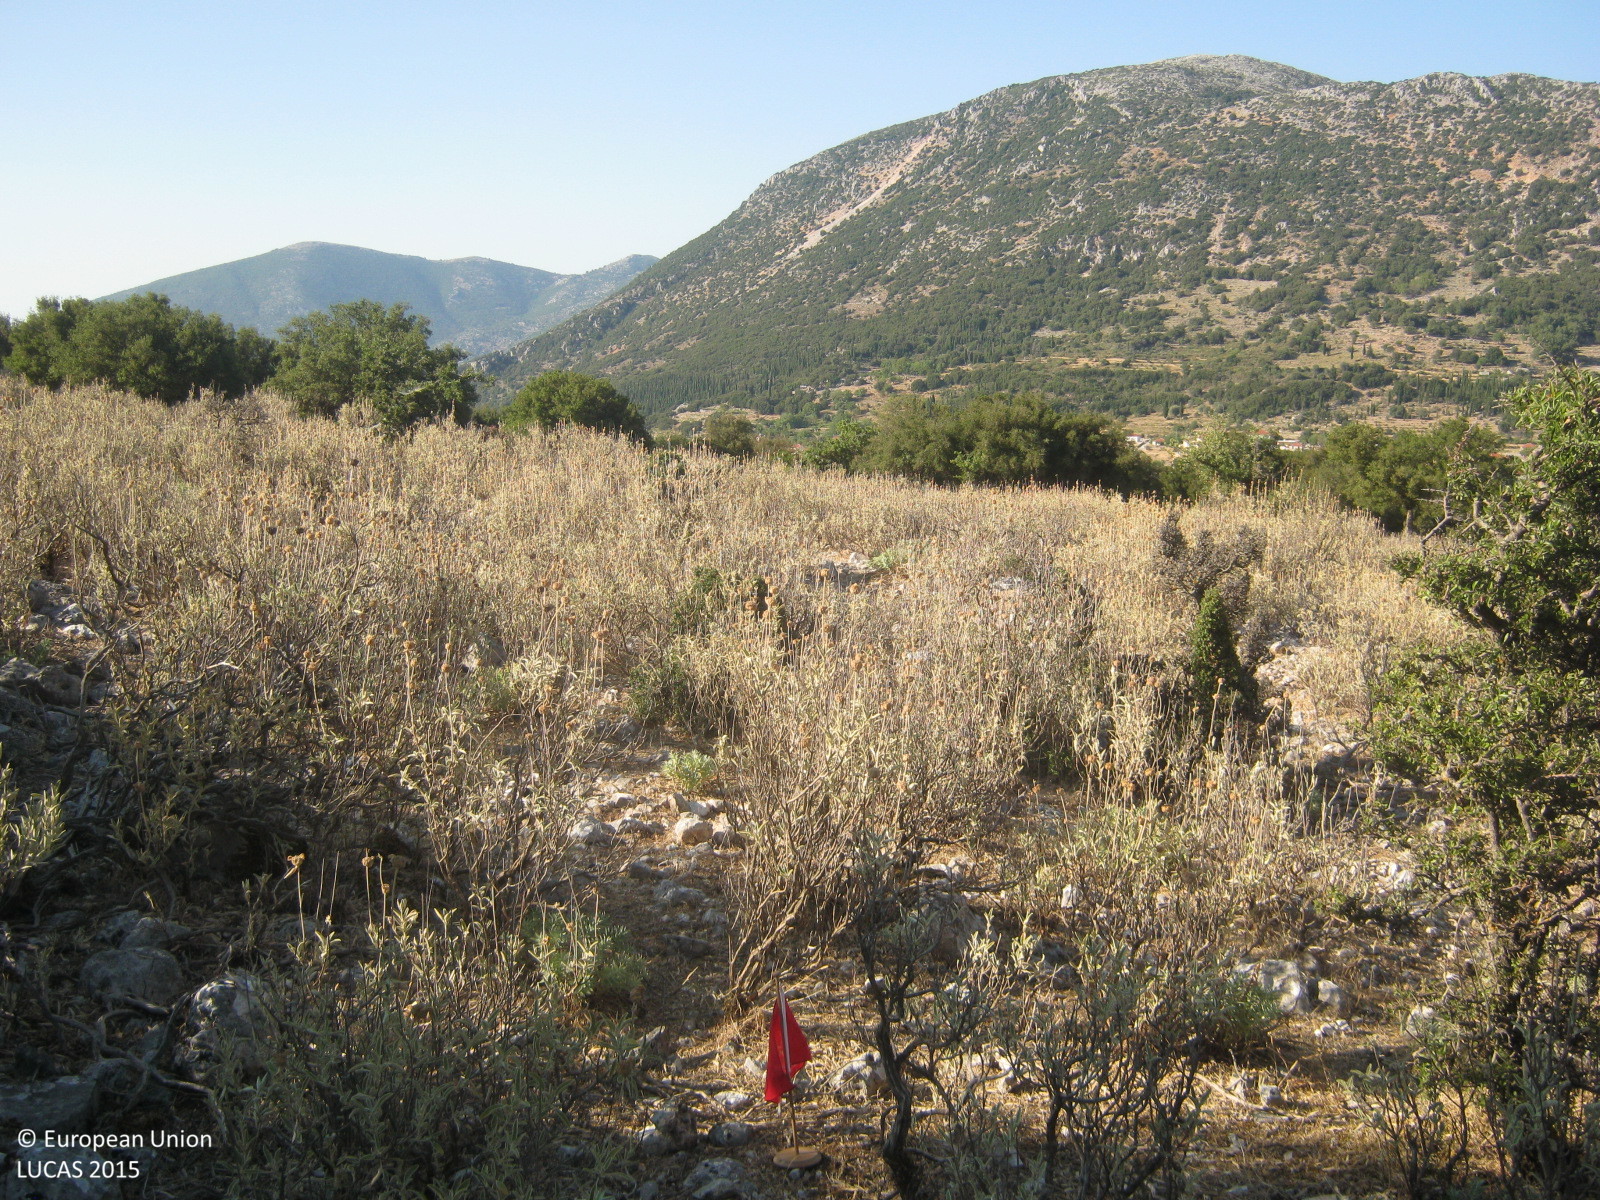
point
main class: Grassland
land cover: Grassland with sparse tree/shrub cover
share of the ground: > 75 %
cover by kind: herbaceous plants 75 %, shrubs 10 %, consolidated bare surface 10 %, broadleaved forest trees 5 %
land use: Semi-natural and natural areas not in use
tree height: < 5 m
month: July
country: GR
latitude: 38.1678
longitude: 20.6791
